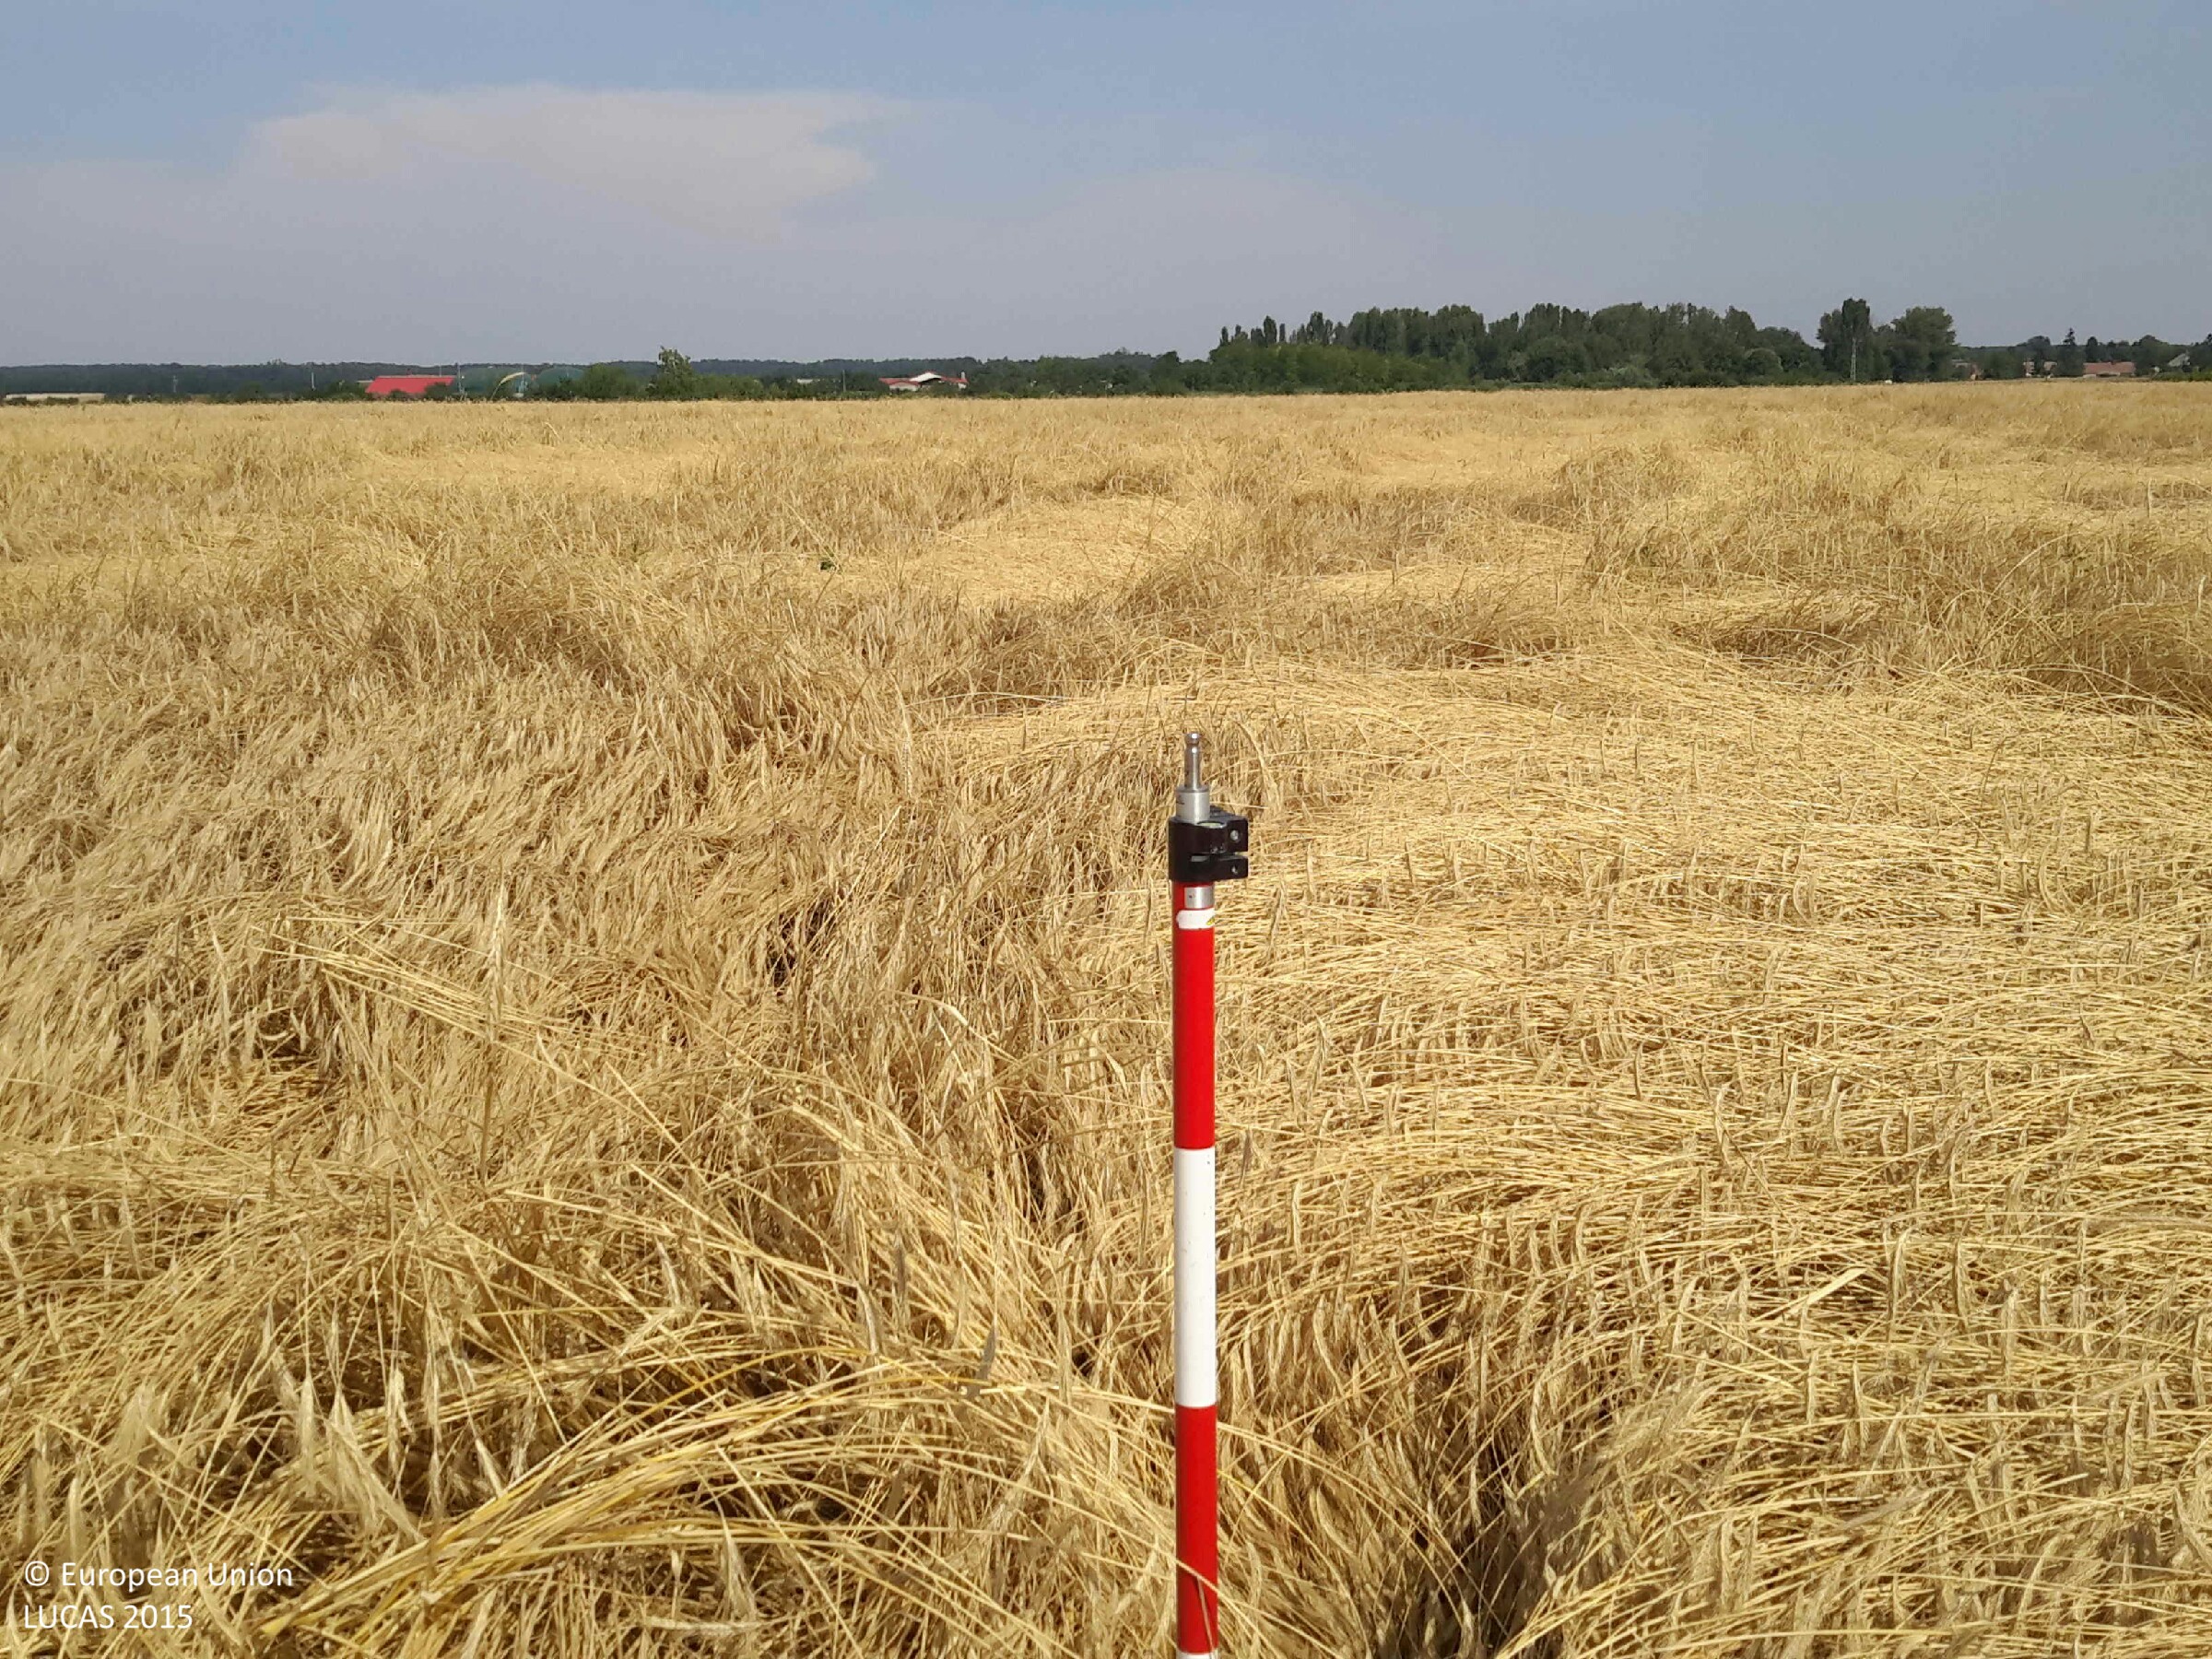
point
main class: Cropland
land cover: Common wheat
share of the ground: > 75 %
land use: Agriculture (excluding fallow land and kitchen gardens)
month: July
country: HU
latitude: 47.3184
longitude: 17.2164
